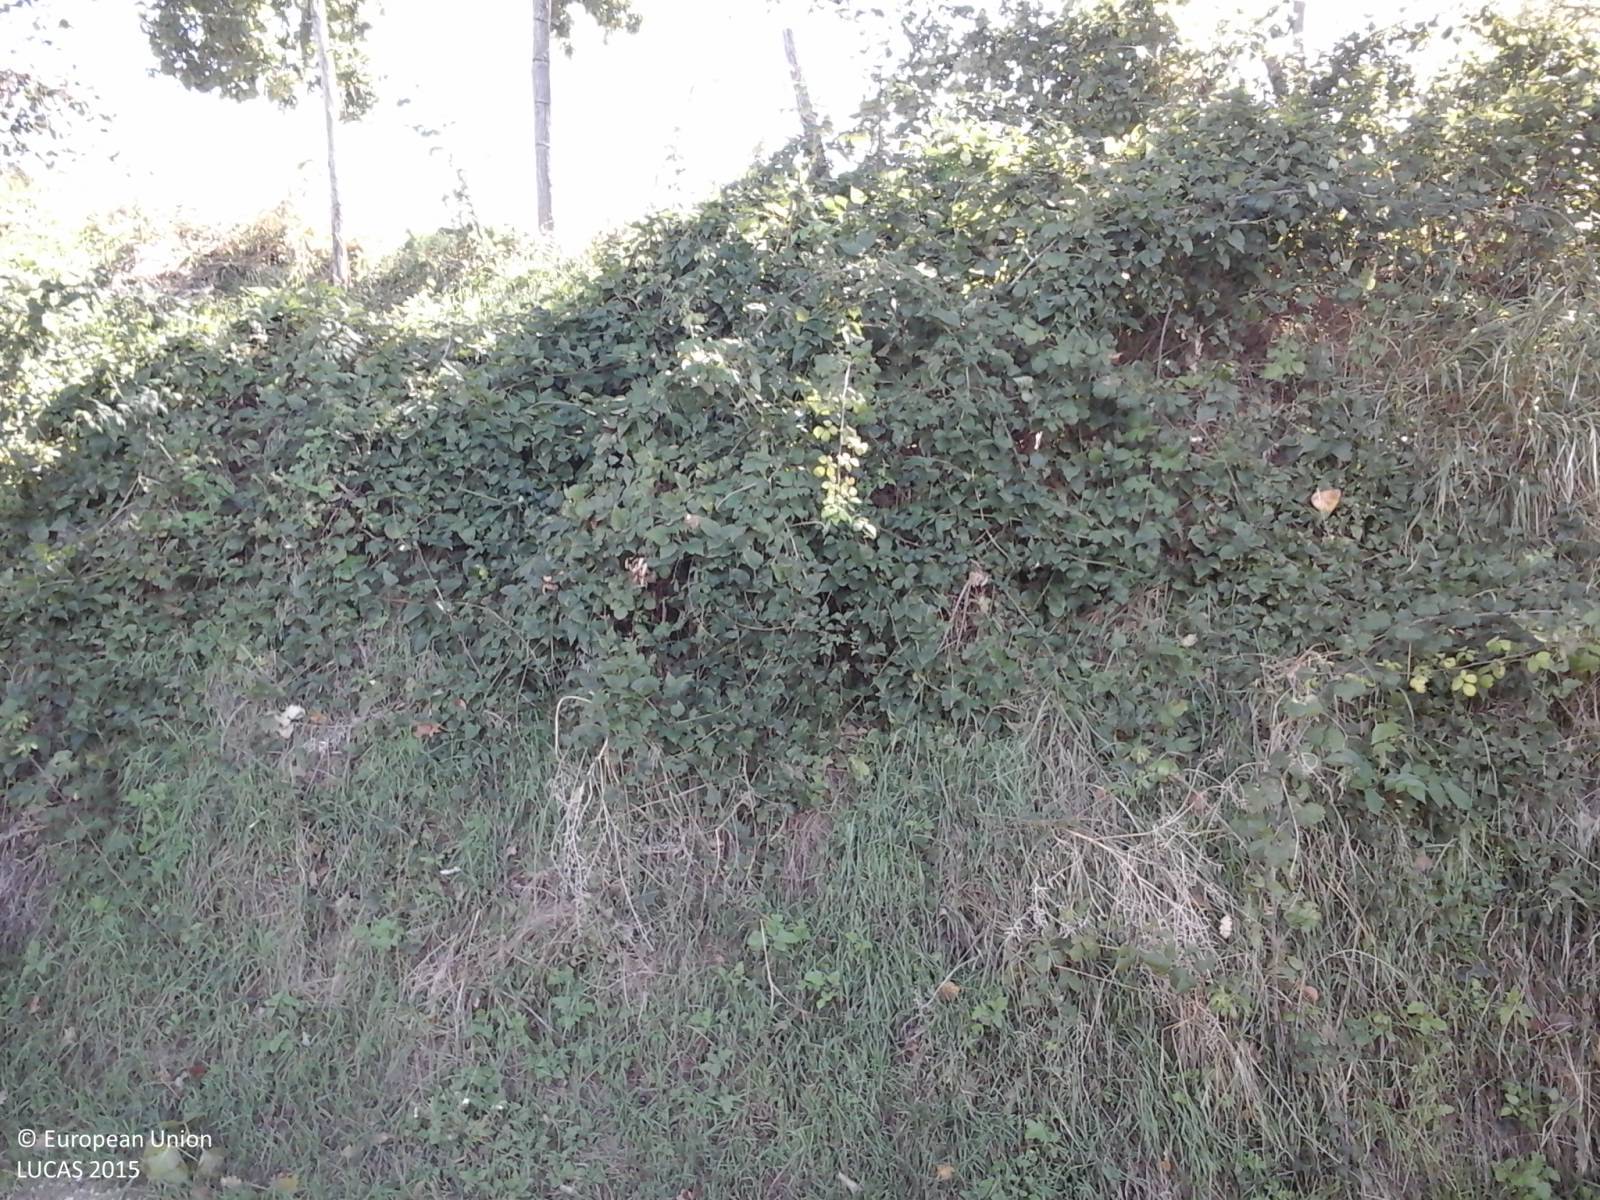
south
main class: Grassland
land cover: Grassland without tree/shrub cover
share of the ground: > 75 %
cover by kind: herbaceous plants 100 %
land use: Agriculture (excluding fallow land and kitchen gardens)
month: September
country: IT
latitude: 42.3514
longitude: 12.5286
